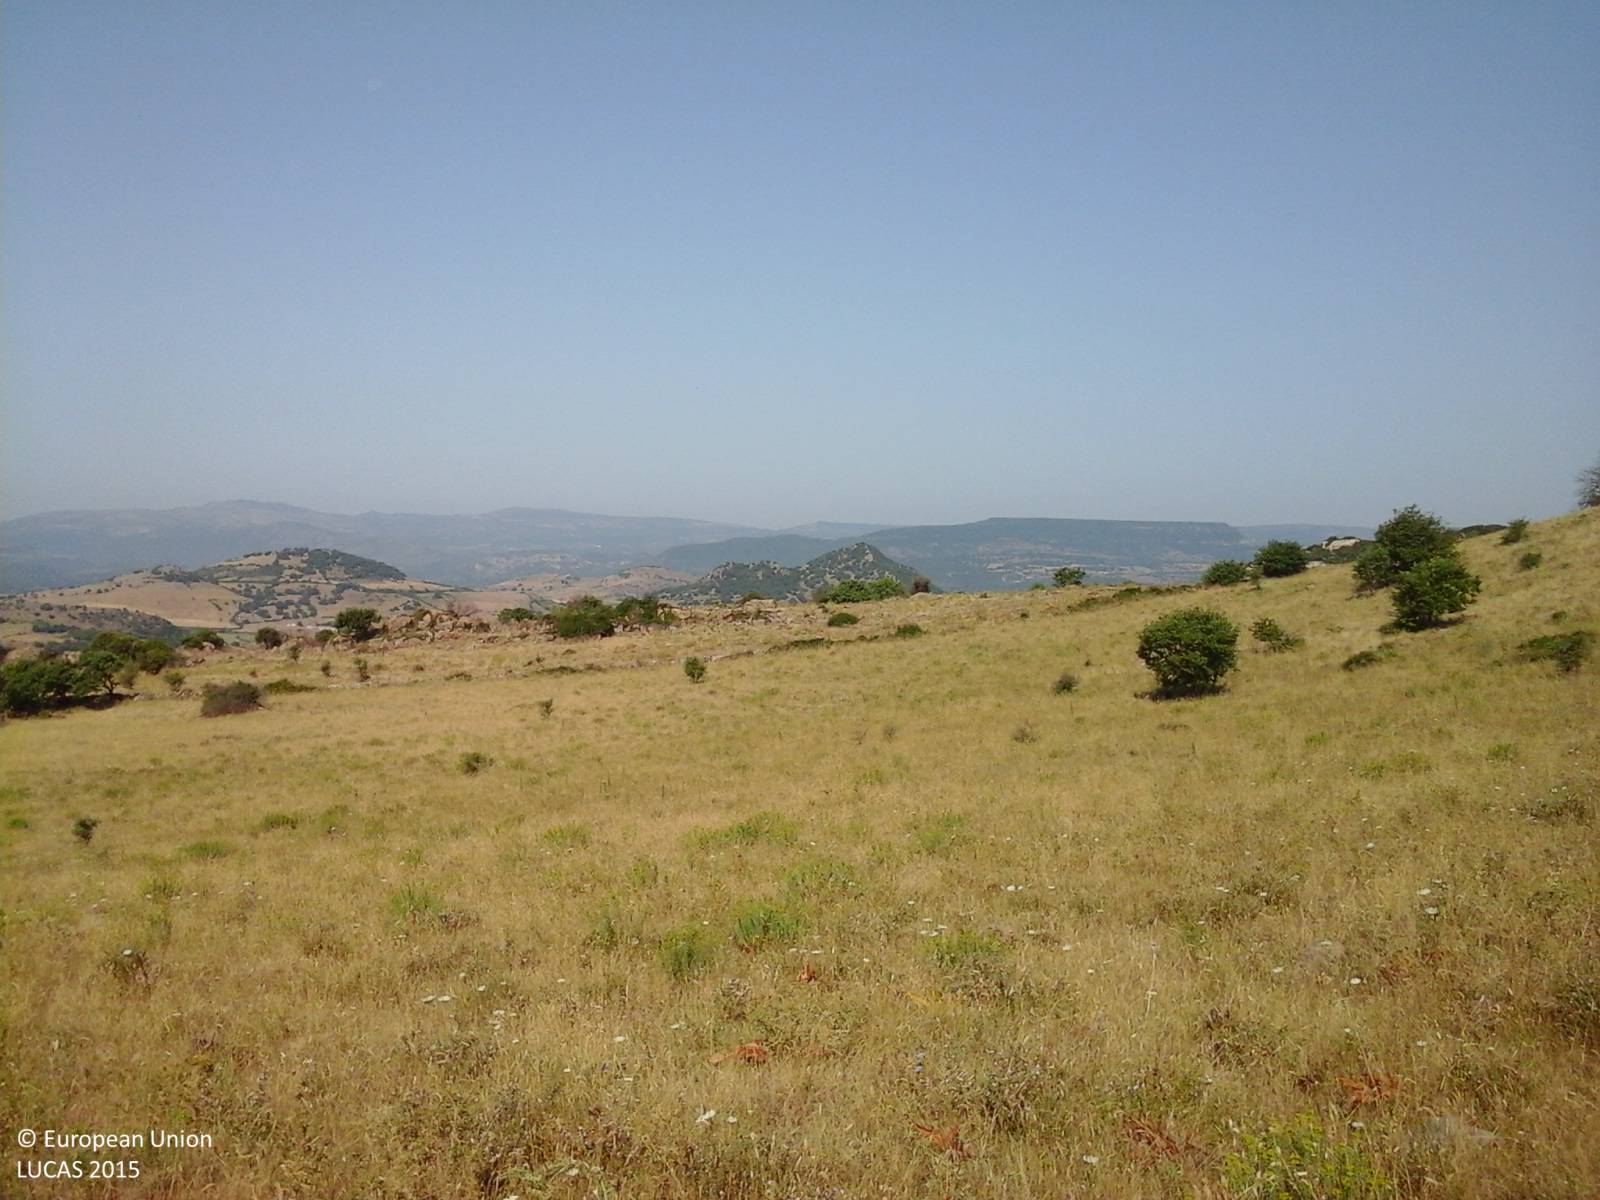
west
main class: Grassland
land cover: Grassland without tree/shrub cover
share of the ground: 50 - 75 %
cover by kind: herbaceous plants 100 %
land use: Agriculture (excluding fallow land and kitchen gardens)
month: July
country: IT
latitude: 40.4394
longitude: 8.6745
